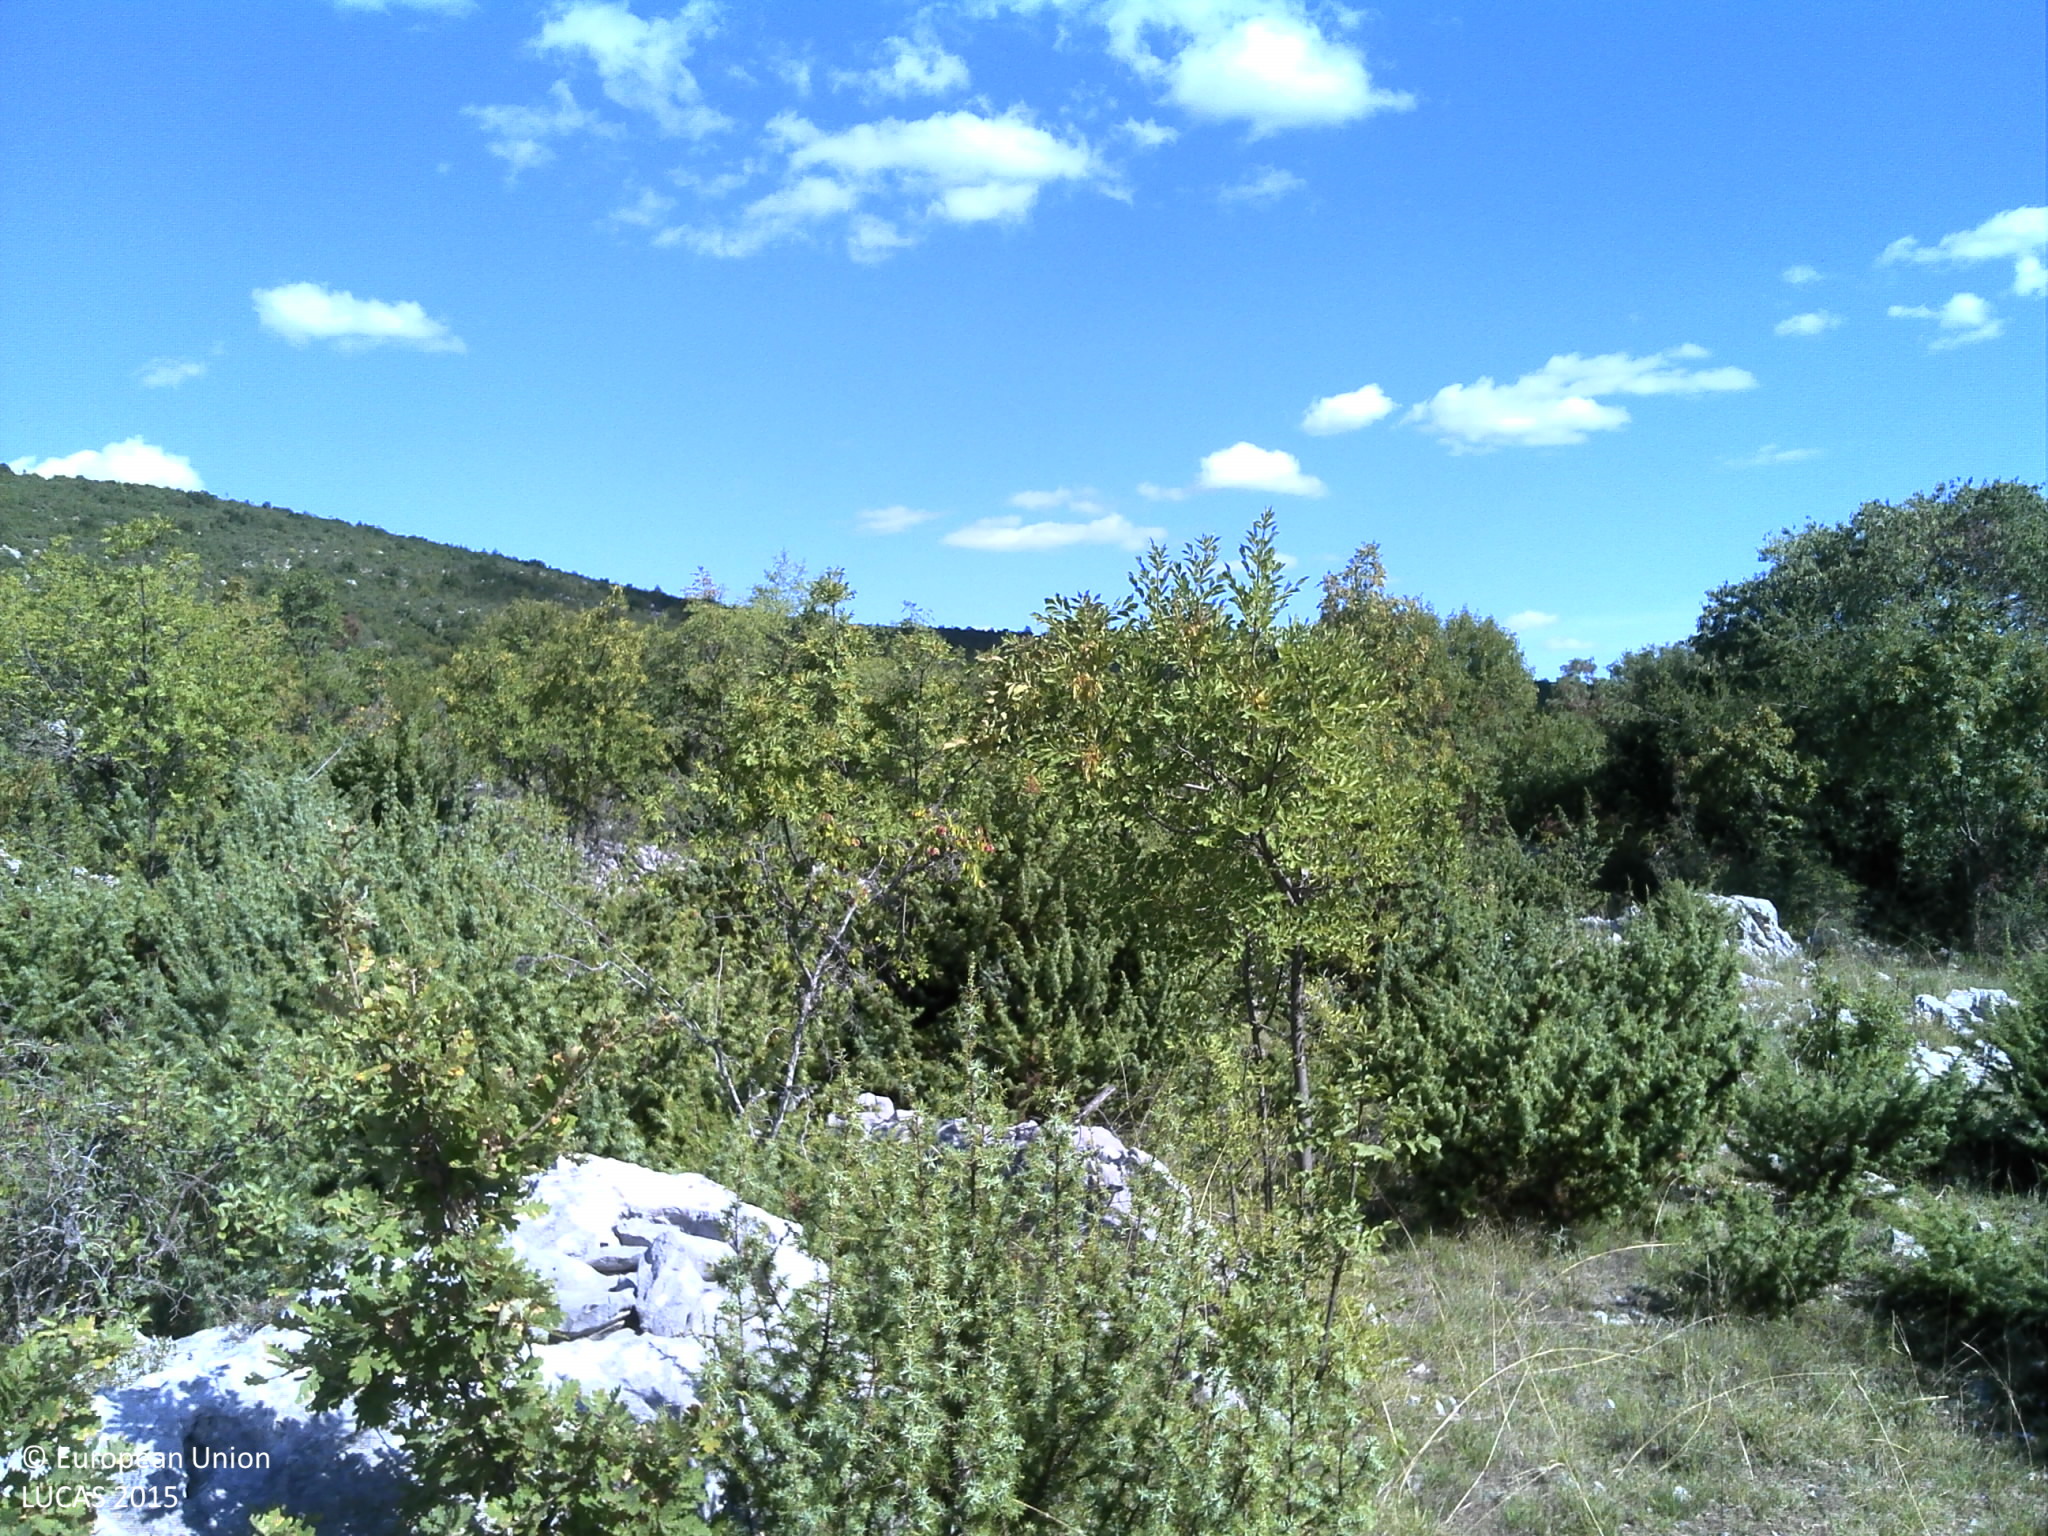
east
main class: Shrubland
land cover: Shrubland without tree cover
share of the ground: 25 - 50 %
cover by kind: consolidated bare surface 35 %, herbaceous plants 30 %, shrubs 25 %, unconsolidated bare surface 10 %
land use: Abandoned areas
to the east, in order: Shrubland without tree cover; Dry stone walls; Shrubland with sparse tree cover; Dry stone walls; Shrubland with sparse tree cover; Dry stone walls; Grassland without tree/shrub cover; Dry stone walls; Grassland without tree/shrub cover; Dry stone walls; Olive groves; Dry stone walls; Tracks; Dry stone walls; Olive groves; Dry stone walls; Olive groves
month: September
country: HR
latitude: 43.6345
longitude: 16.3002
